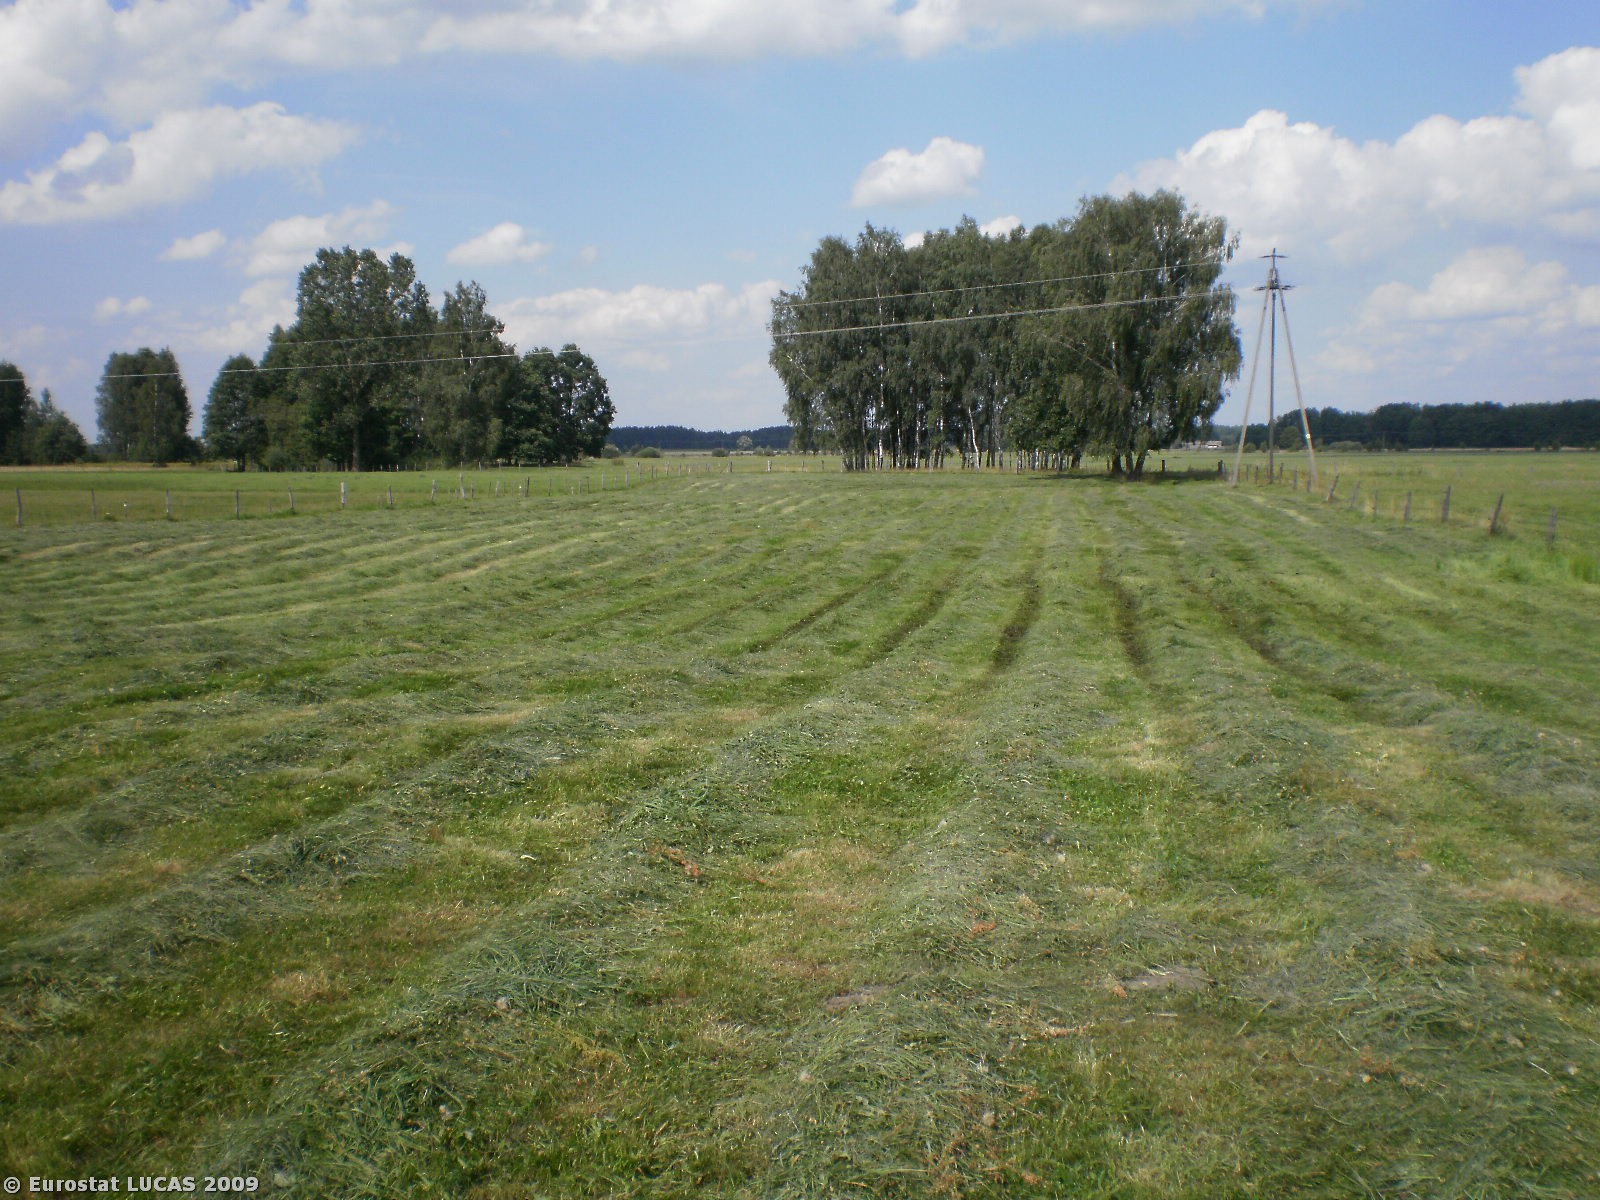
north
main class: Grassland
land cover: Grassland without tree/shrub cover
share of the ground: > 75 %
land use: Agriculture (excluding fallow land and kitchen gardens)
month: July
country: PL
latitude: 53.3967
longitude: 21.3117
